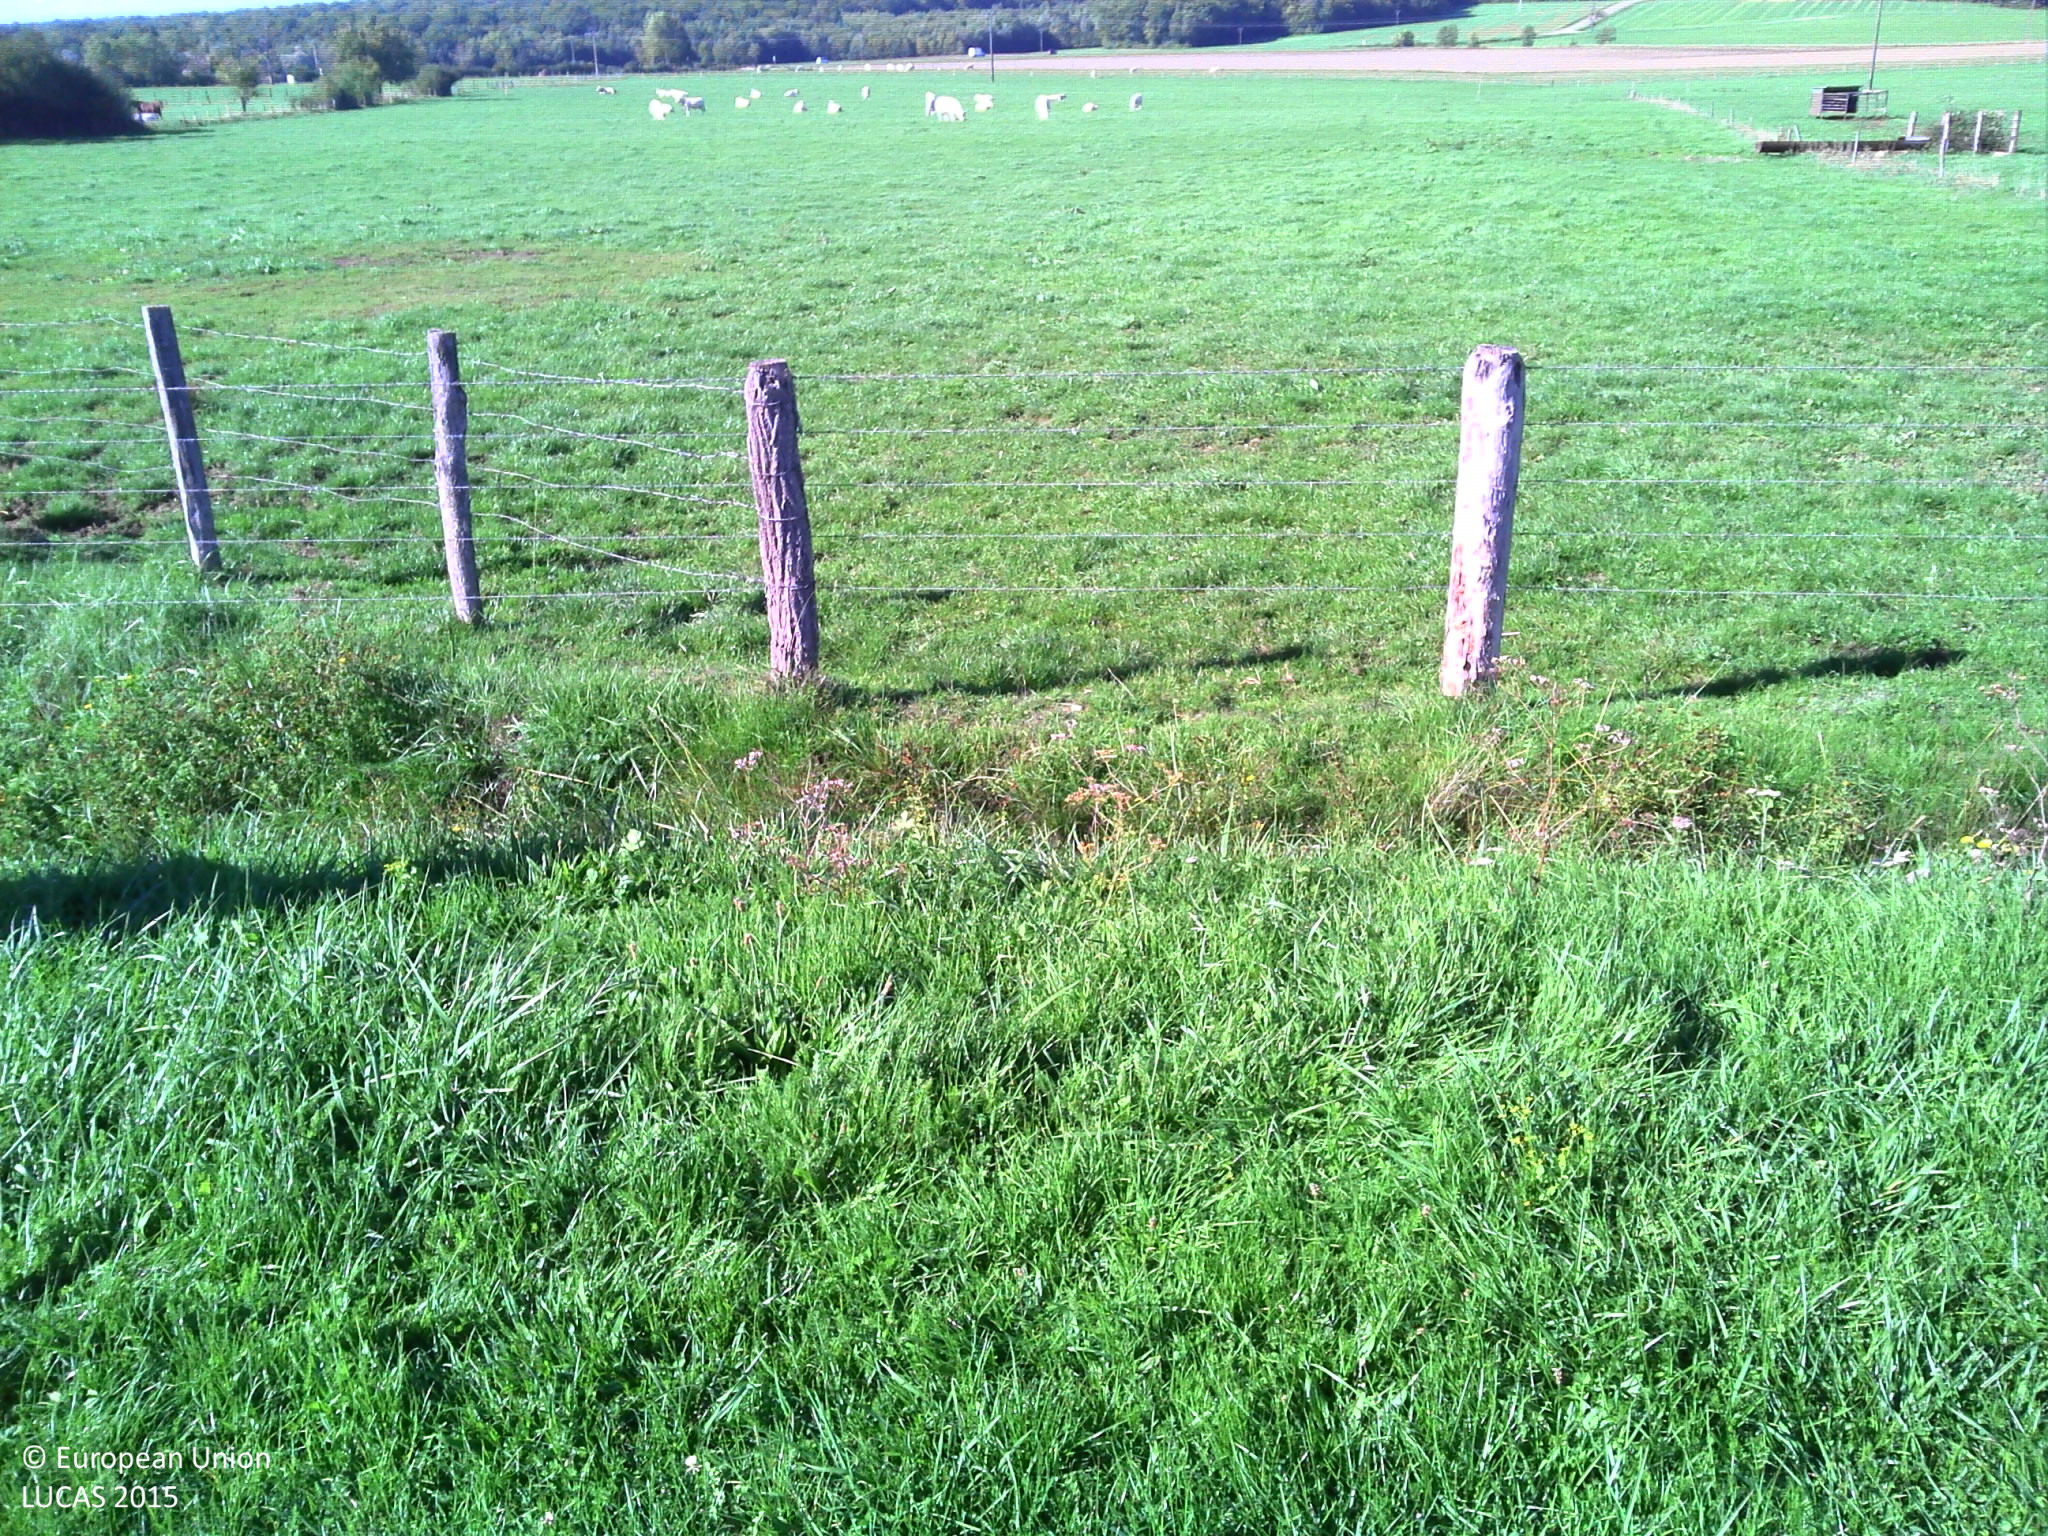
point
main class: Grassland
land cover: Grassland without tree/shrub cover
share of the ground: > 75 %
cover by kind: herbaceous plants 100 %
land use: Agriculture (excluding fallow land and kitchen gardens)
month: September
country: FR
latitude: 48.2427
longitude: 4.3821
